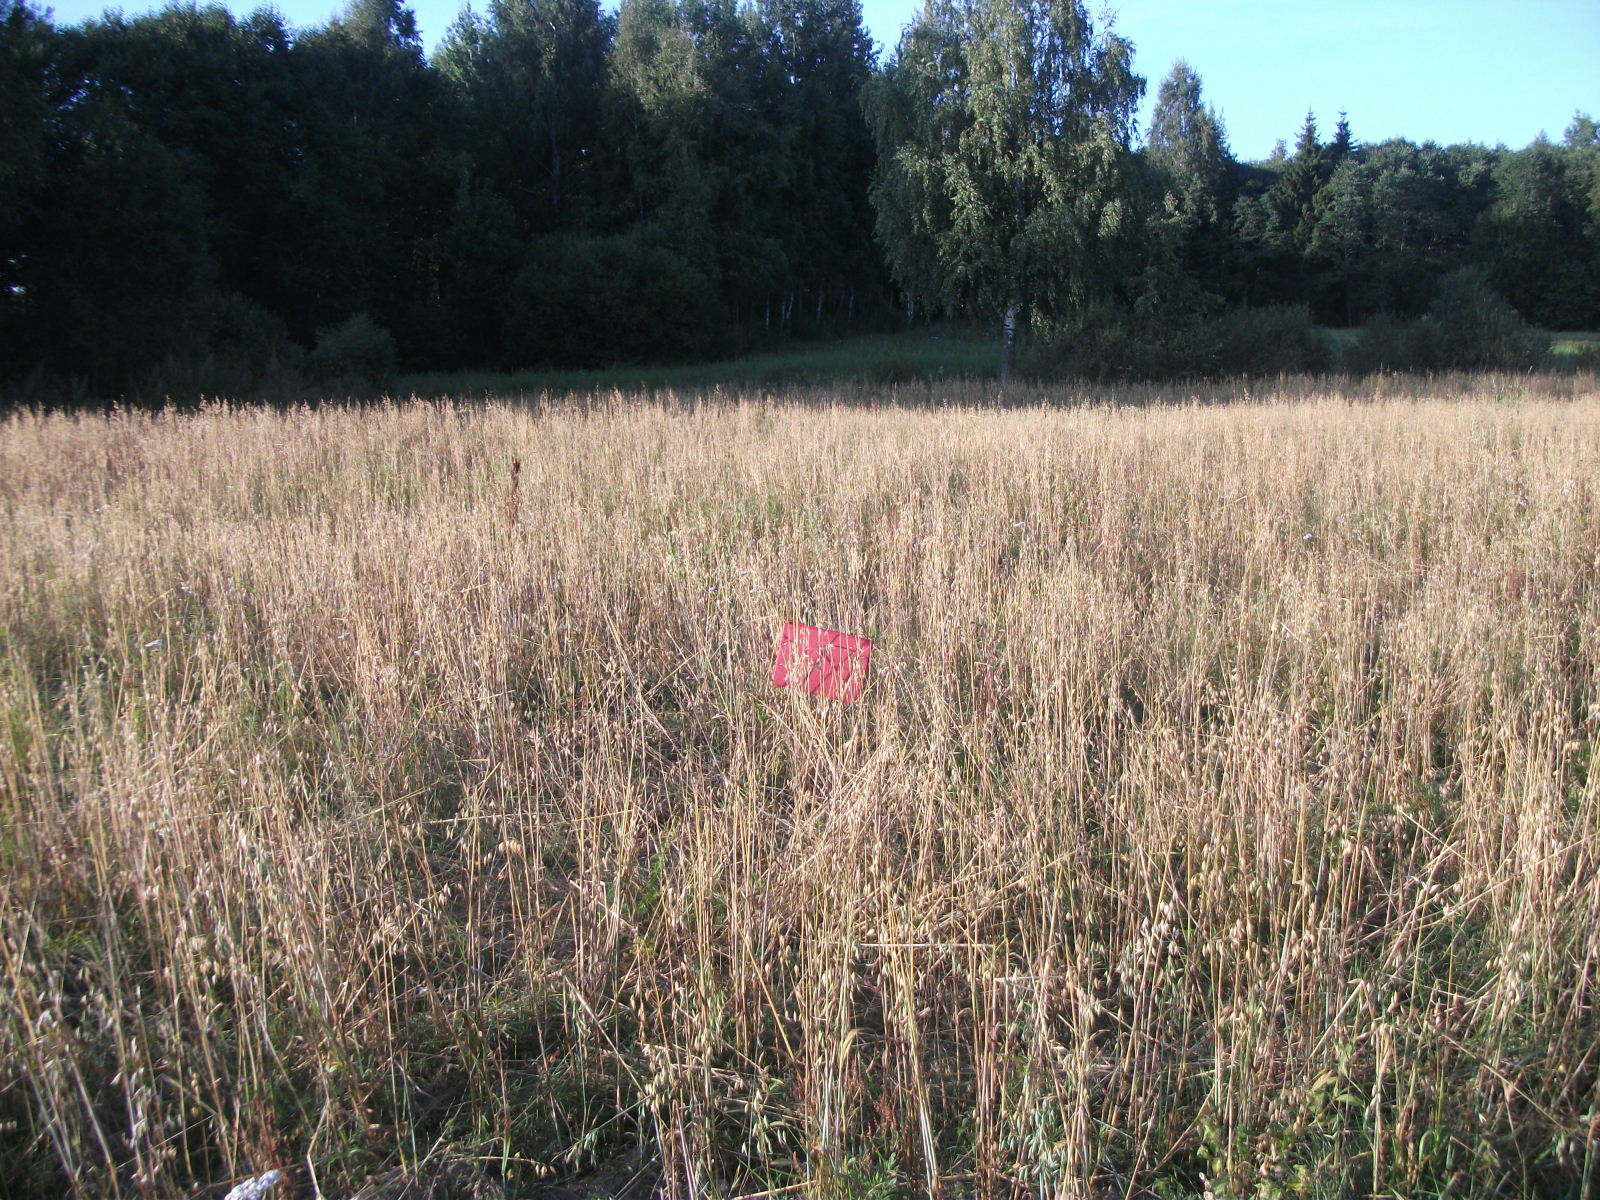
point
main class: Cropland
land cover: Oats
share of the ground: > 75 %
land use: Agriculture (excluding fallow land and kitchen gardens)
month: August
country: LV
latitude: 56.3989
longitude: 26.1959
